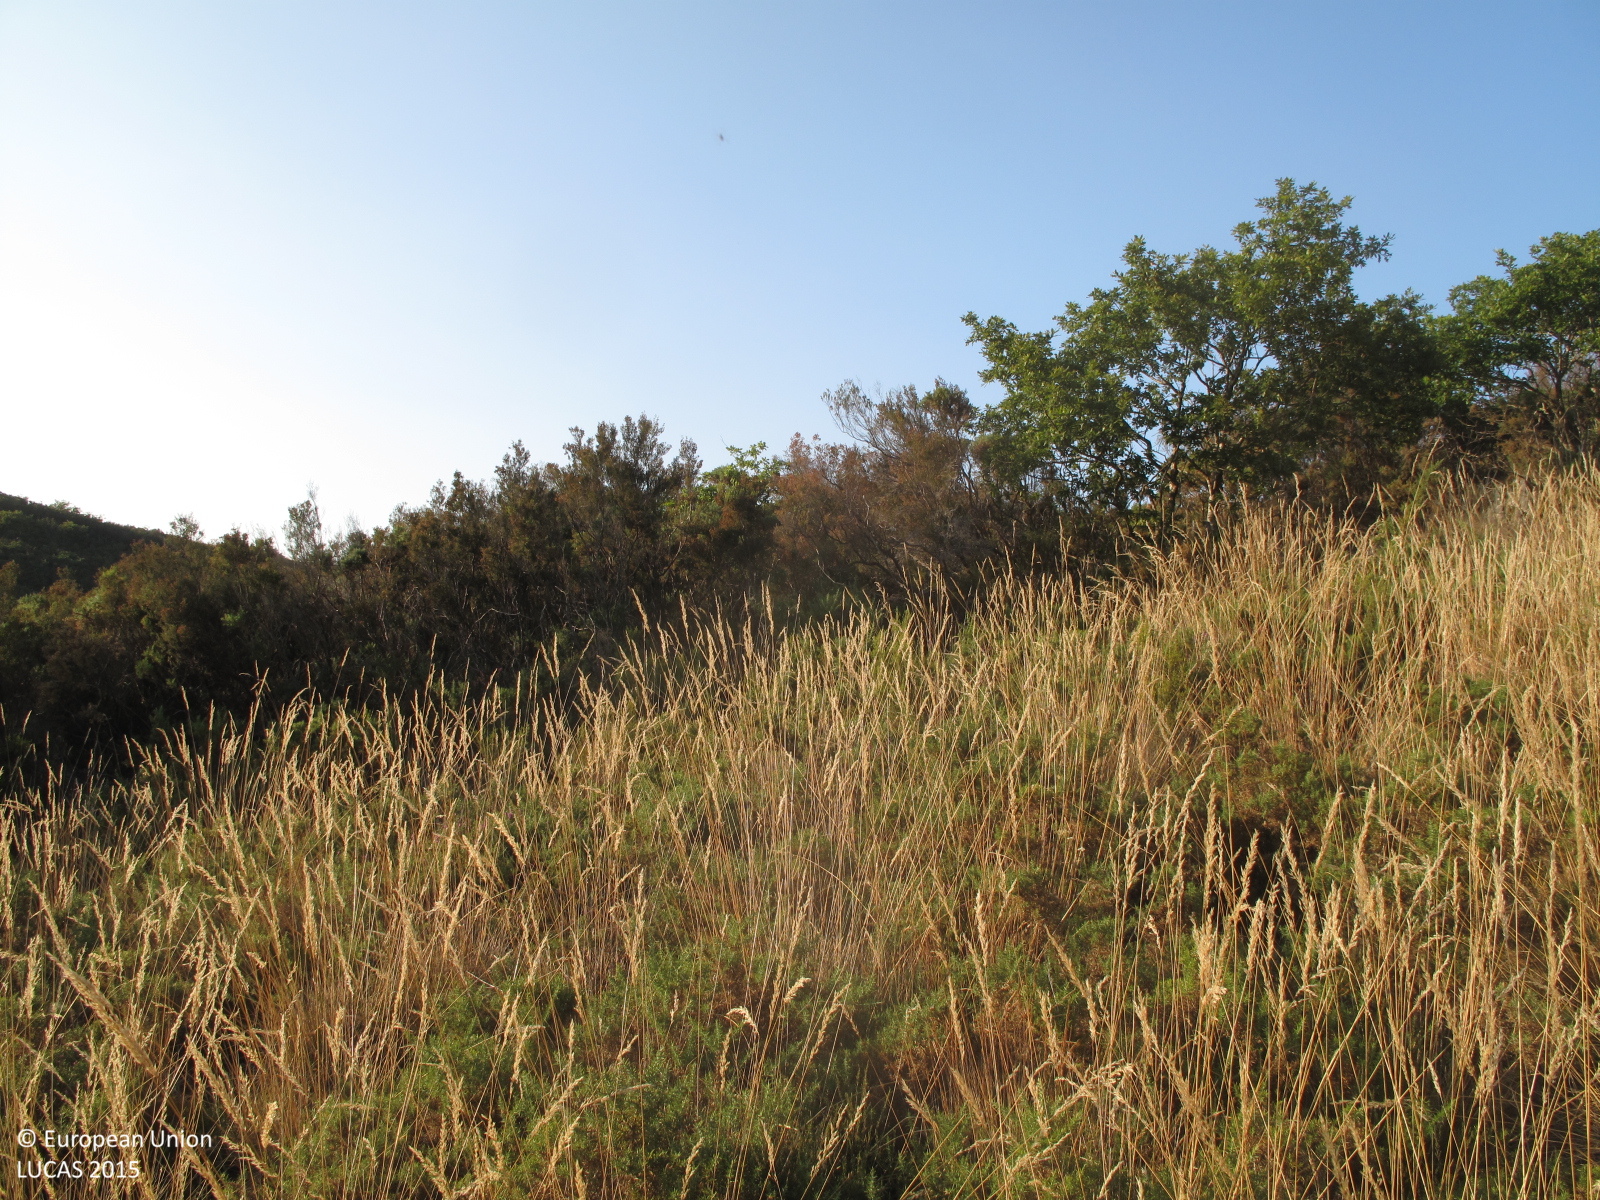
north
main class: Woodland
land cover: Broadleaved woodland
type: acidophilous oak and oak-birch forest
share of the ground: > 75 %
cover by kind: broadleaved forest trees 90 %, shrubs 10 %
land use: Semi-natural and natural areas not in use
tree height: > 5 m
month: July
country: ES
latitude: 43.4126
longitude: -7.9639
